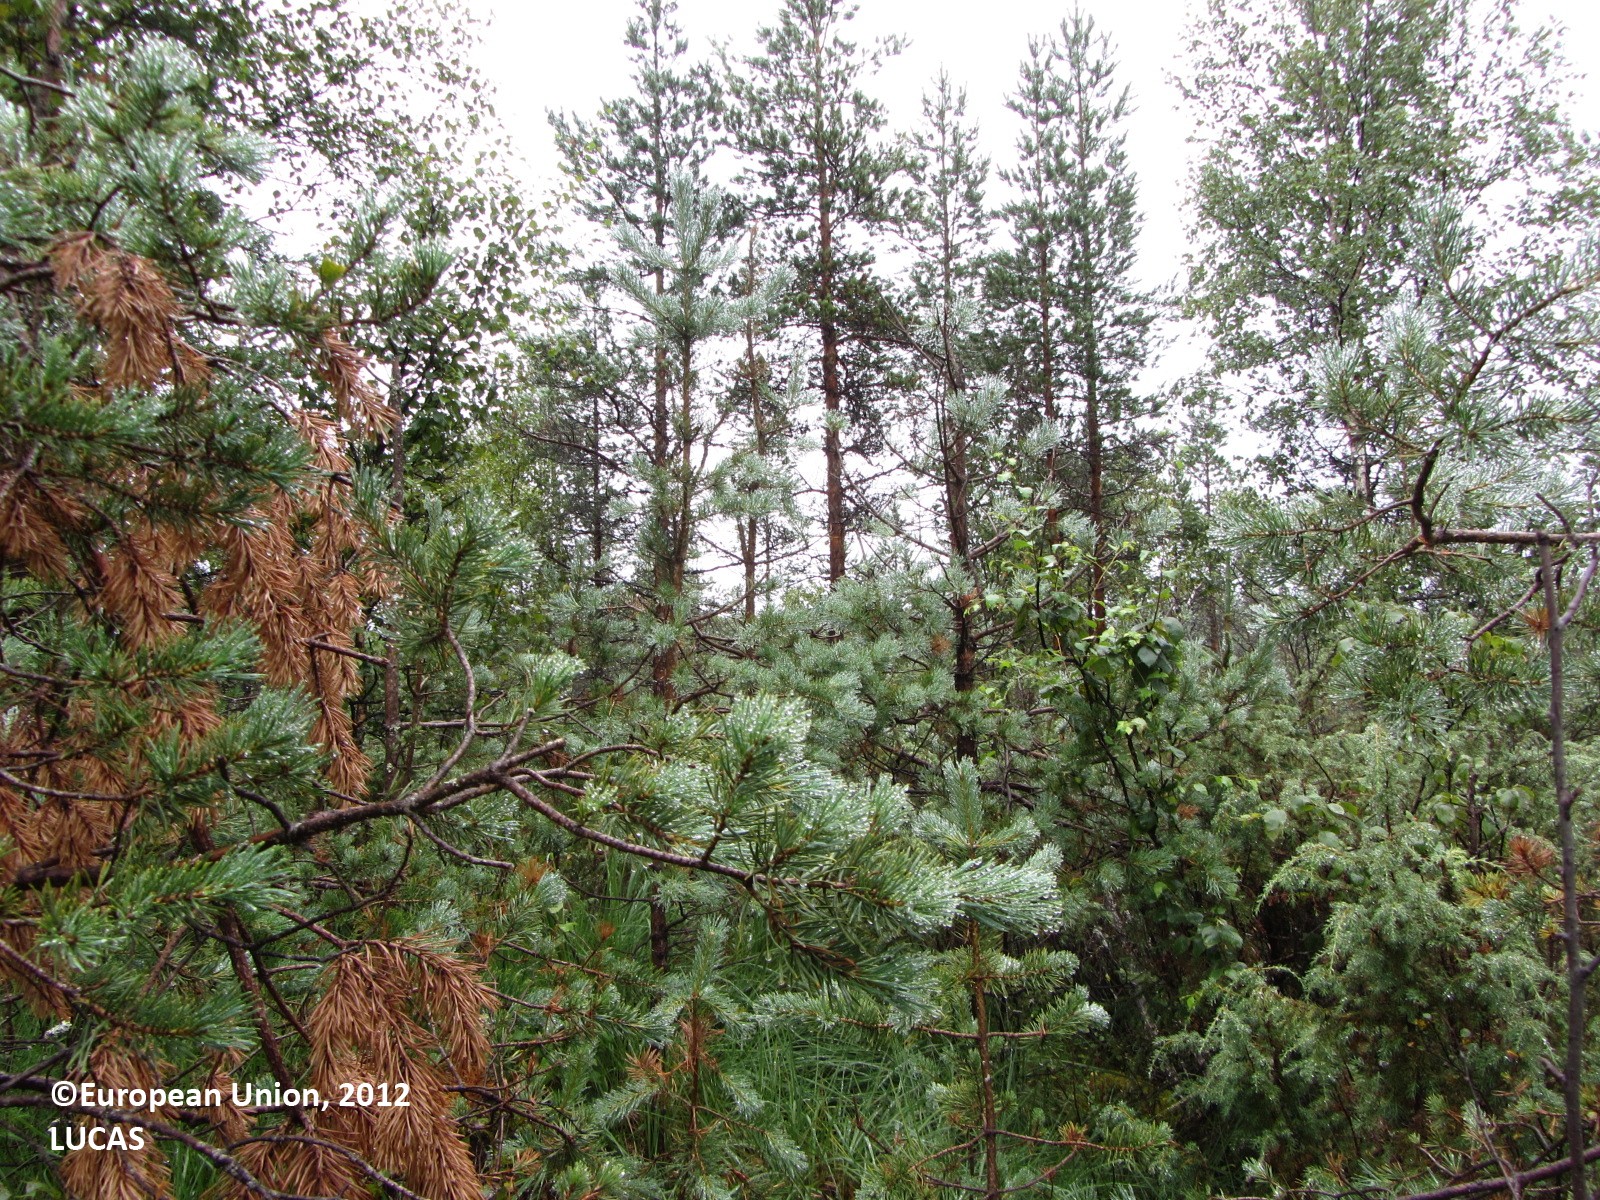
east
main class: Woodland
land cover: Pine dominated mixed woodland
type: boreal forest
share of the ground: > 75 %
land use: Forestry
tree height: > 5 m
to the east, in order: Pine dominated mixed woodland; Ditches and canals; Pine dominated mixed woodland; Ditches and canals; Pine dominated mixed woodland; Ditches and canals; Pine dominated mixed woodland; Ditches and canals; Pine dominated mixed woodland; Ditches and canals; Pine dominated mixed woodland; Ditches and canals; Pine dominated mixed woodland
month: August
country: FI
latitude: 63.3558
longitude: 24.5328
